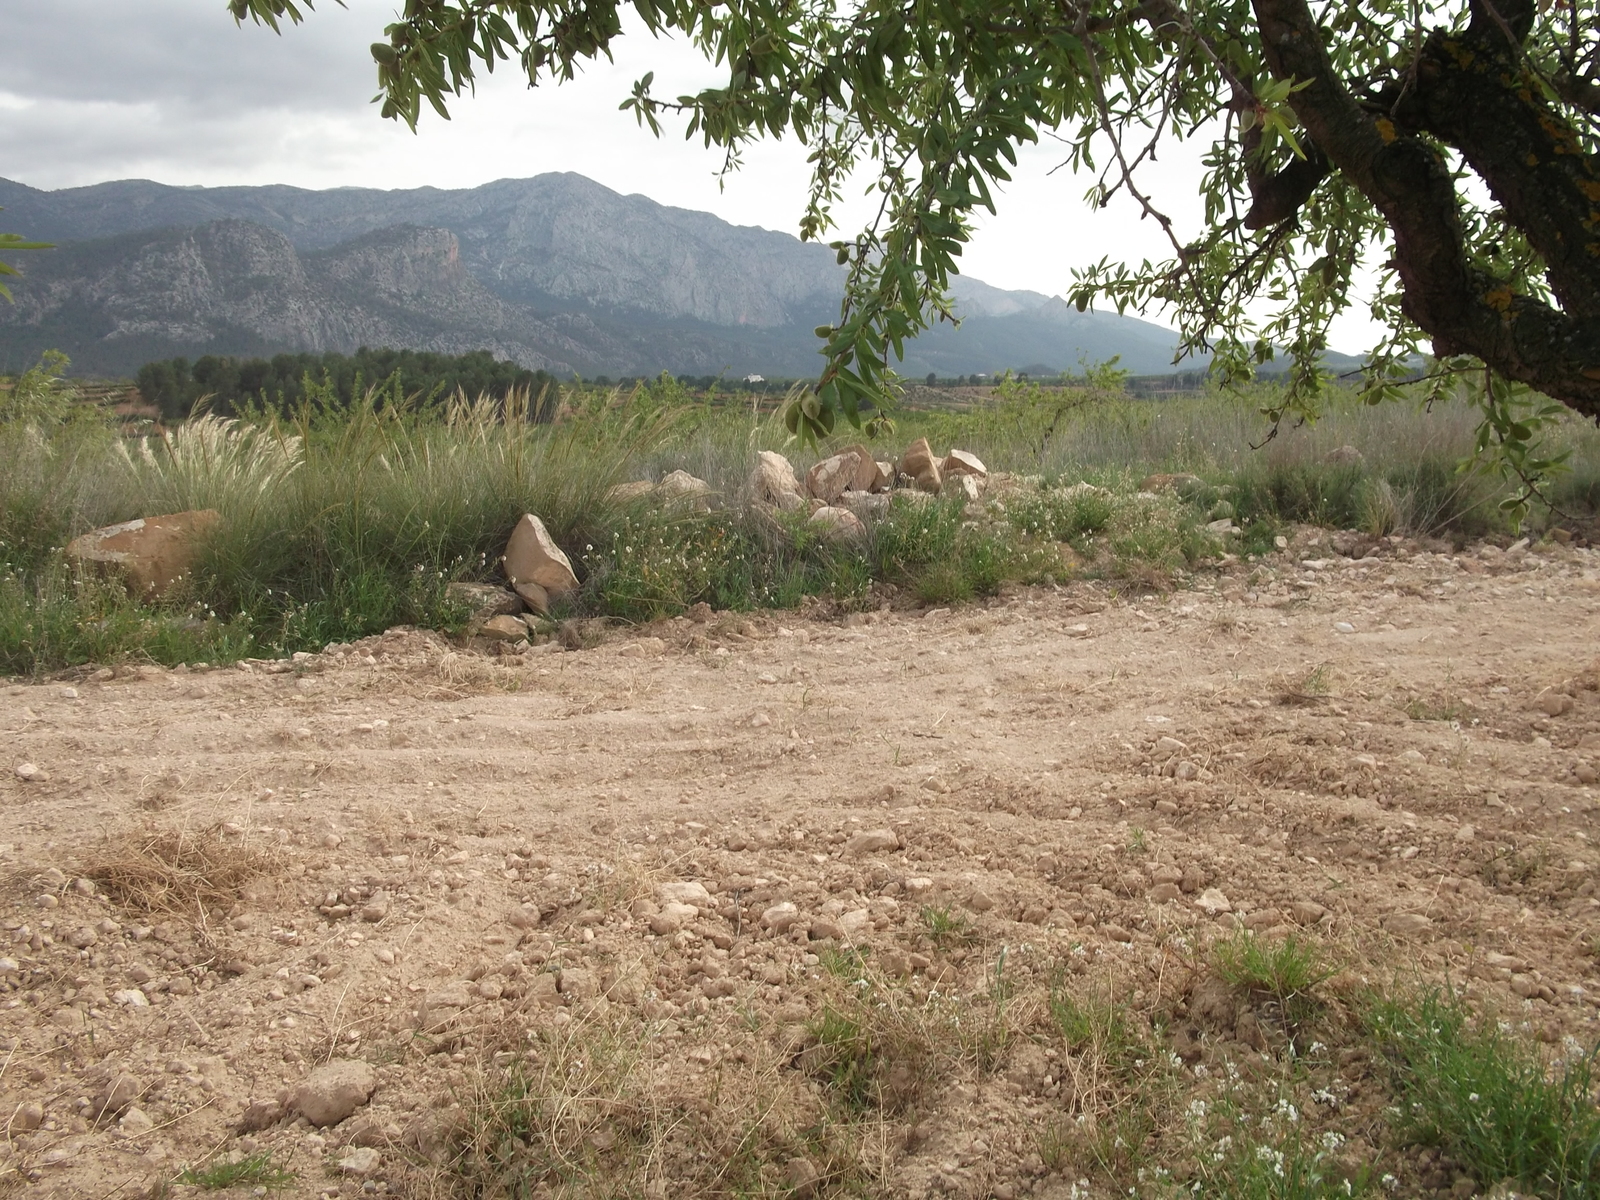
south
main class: Cropland
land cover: Nuts trees
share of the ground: < 10 %
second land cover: Spontaneously vegetated surfaces
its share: > 75 %
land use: Agriculture (excluding fallow land and kitchen gardens)
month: April
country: ES
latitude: 37.9522
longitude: -1.5824
